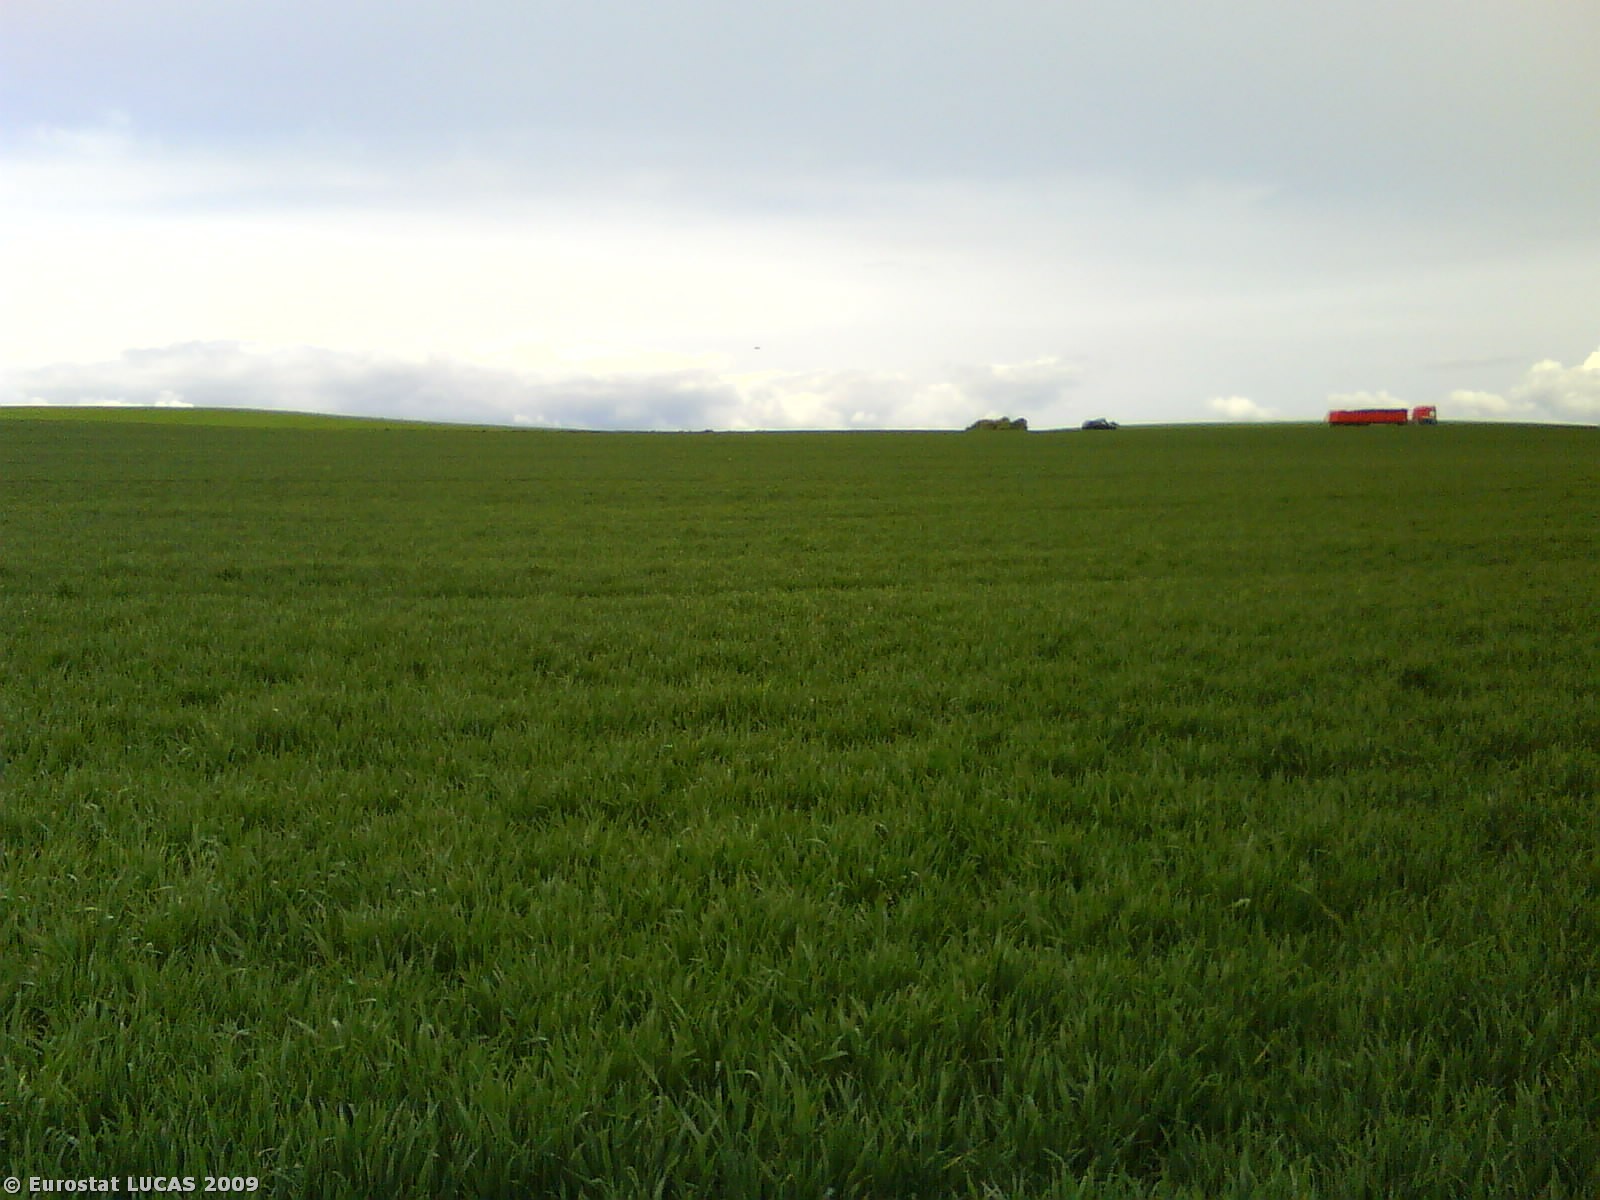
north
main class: Cropland
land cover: Common wheat
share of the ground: > 75 %
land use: Agriculture (excluding fallow land and kitchen gardens)
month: May
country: DK
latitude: 56.3314
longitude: 10.2100
